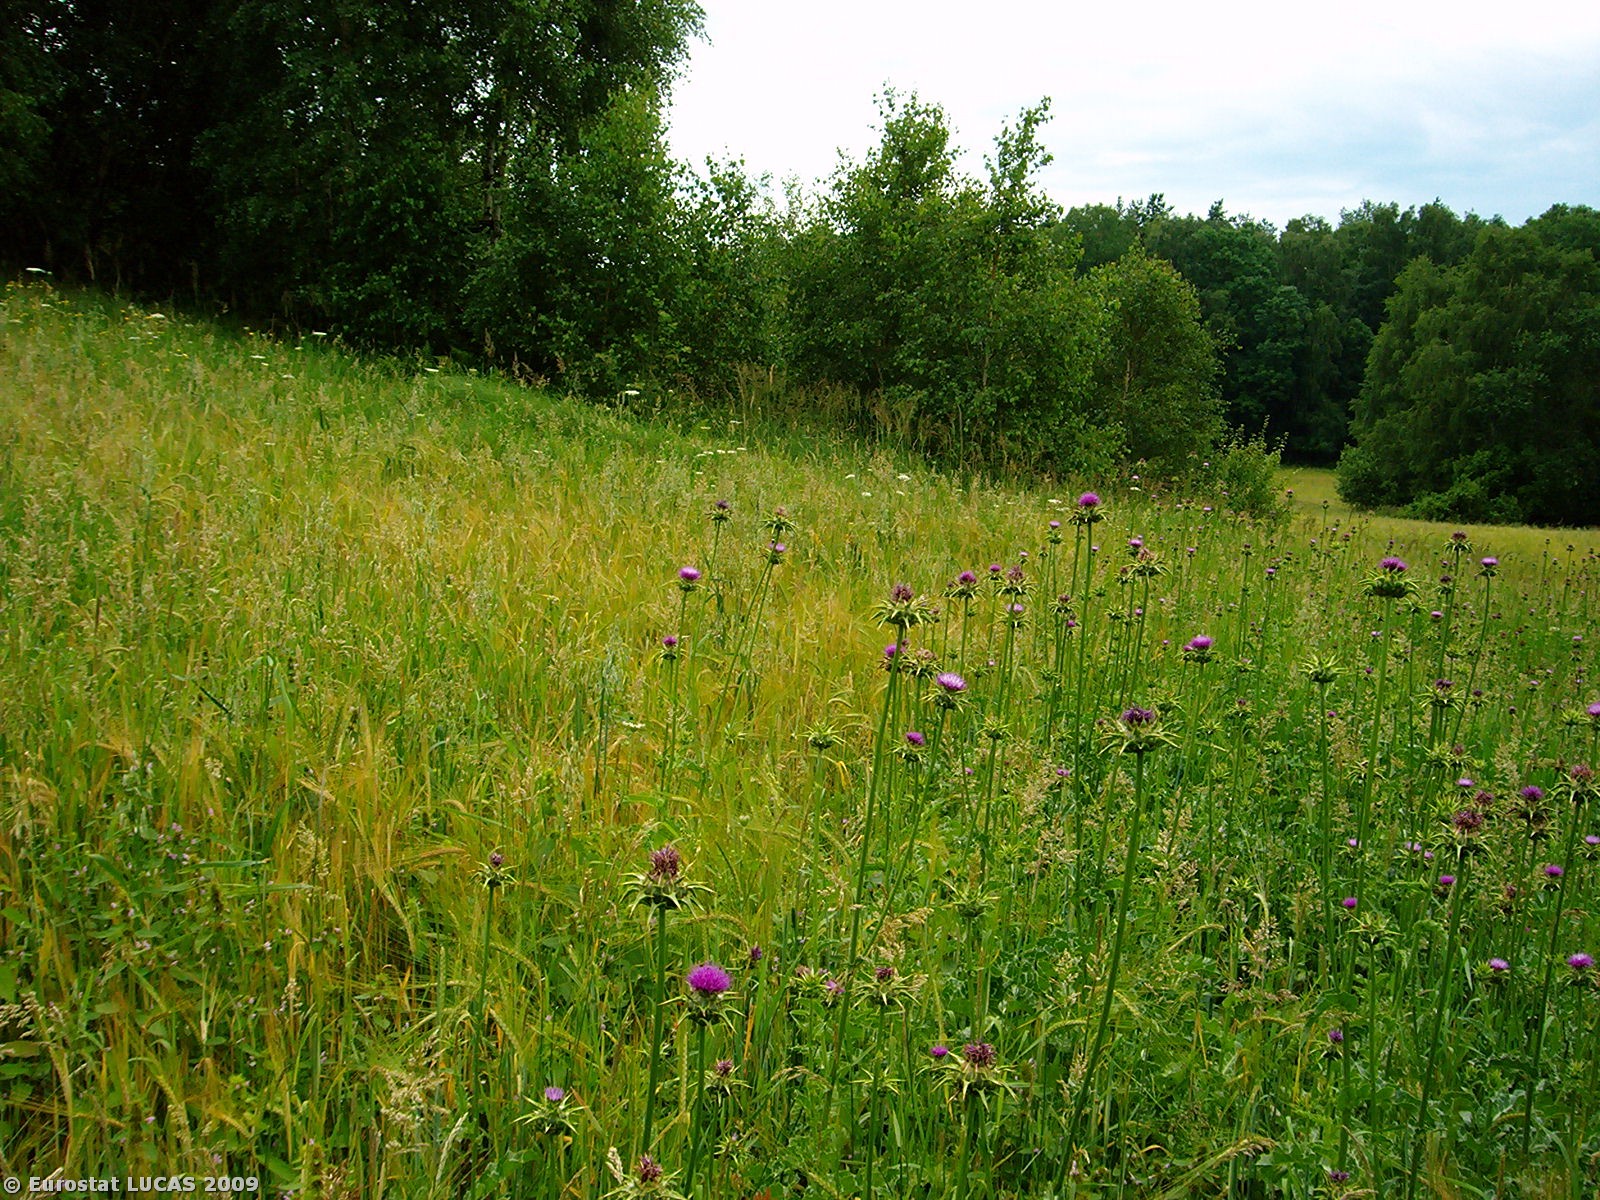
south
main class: Cropland
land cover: Other leguminous and mixtures for fodder
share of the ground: > 75 %
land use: Agriculture (excluding fallow land and kitchen gardens)
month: July
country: PL
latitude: 52.3823
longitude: 15.3660
